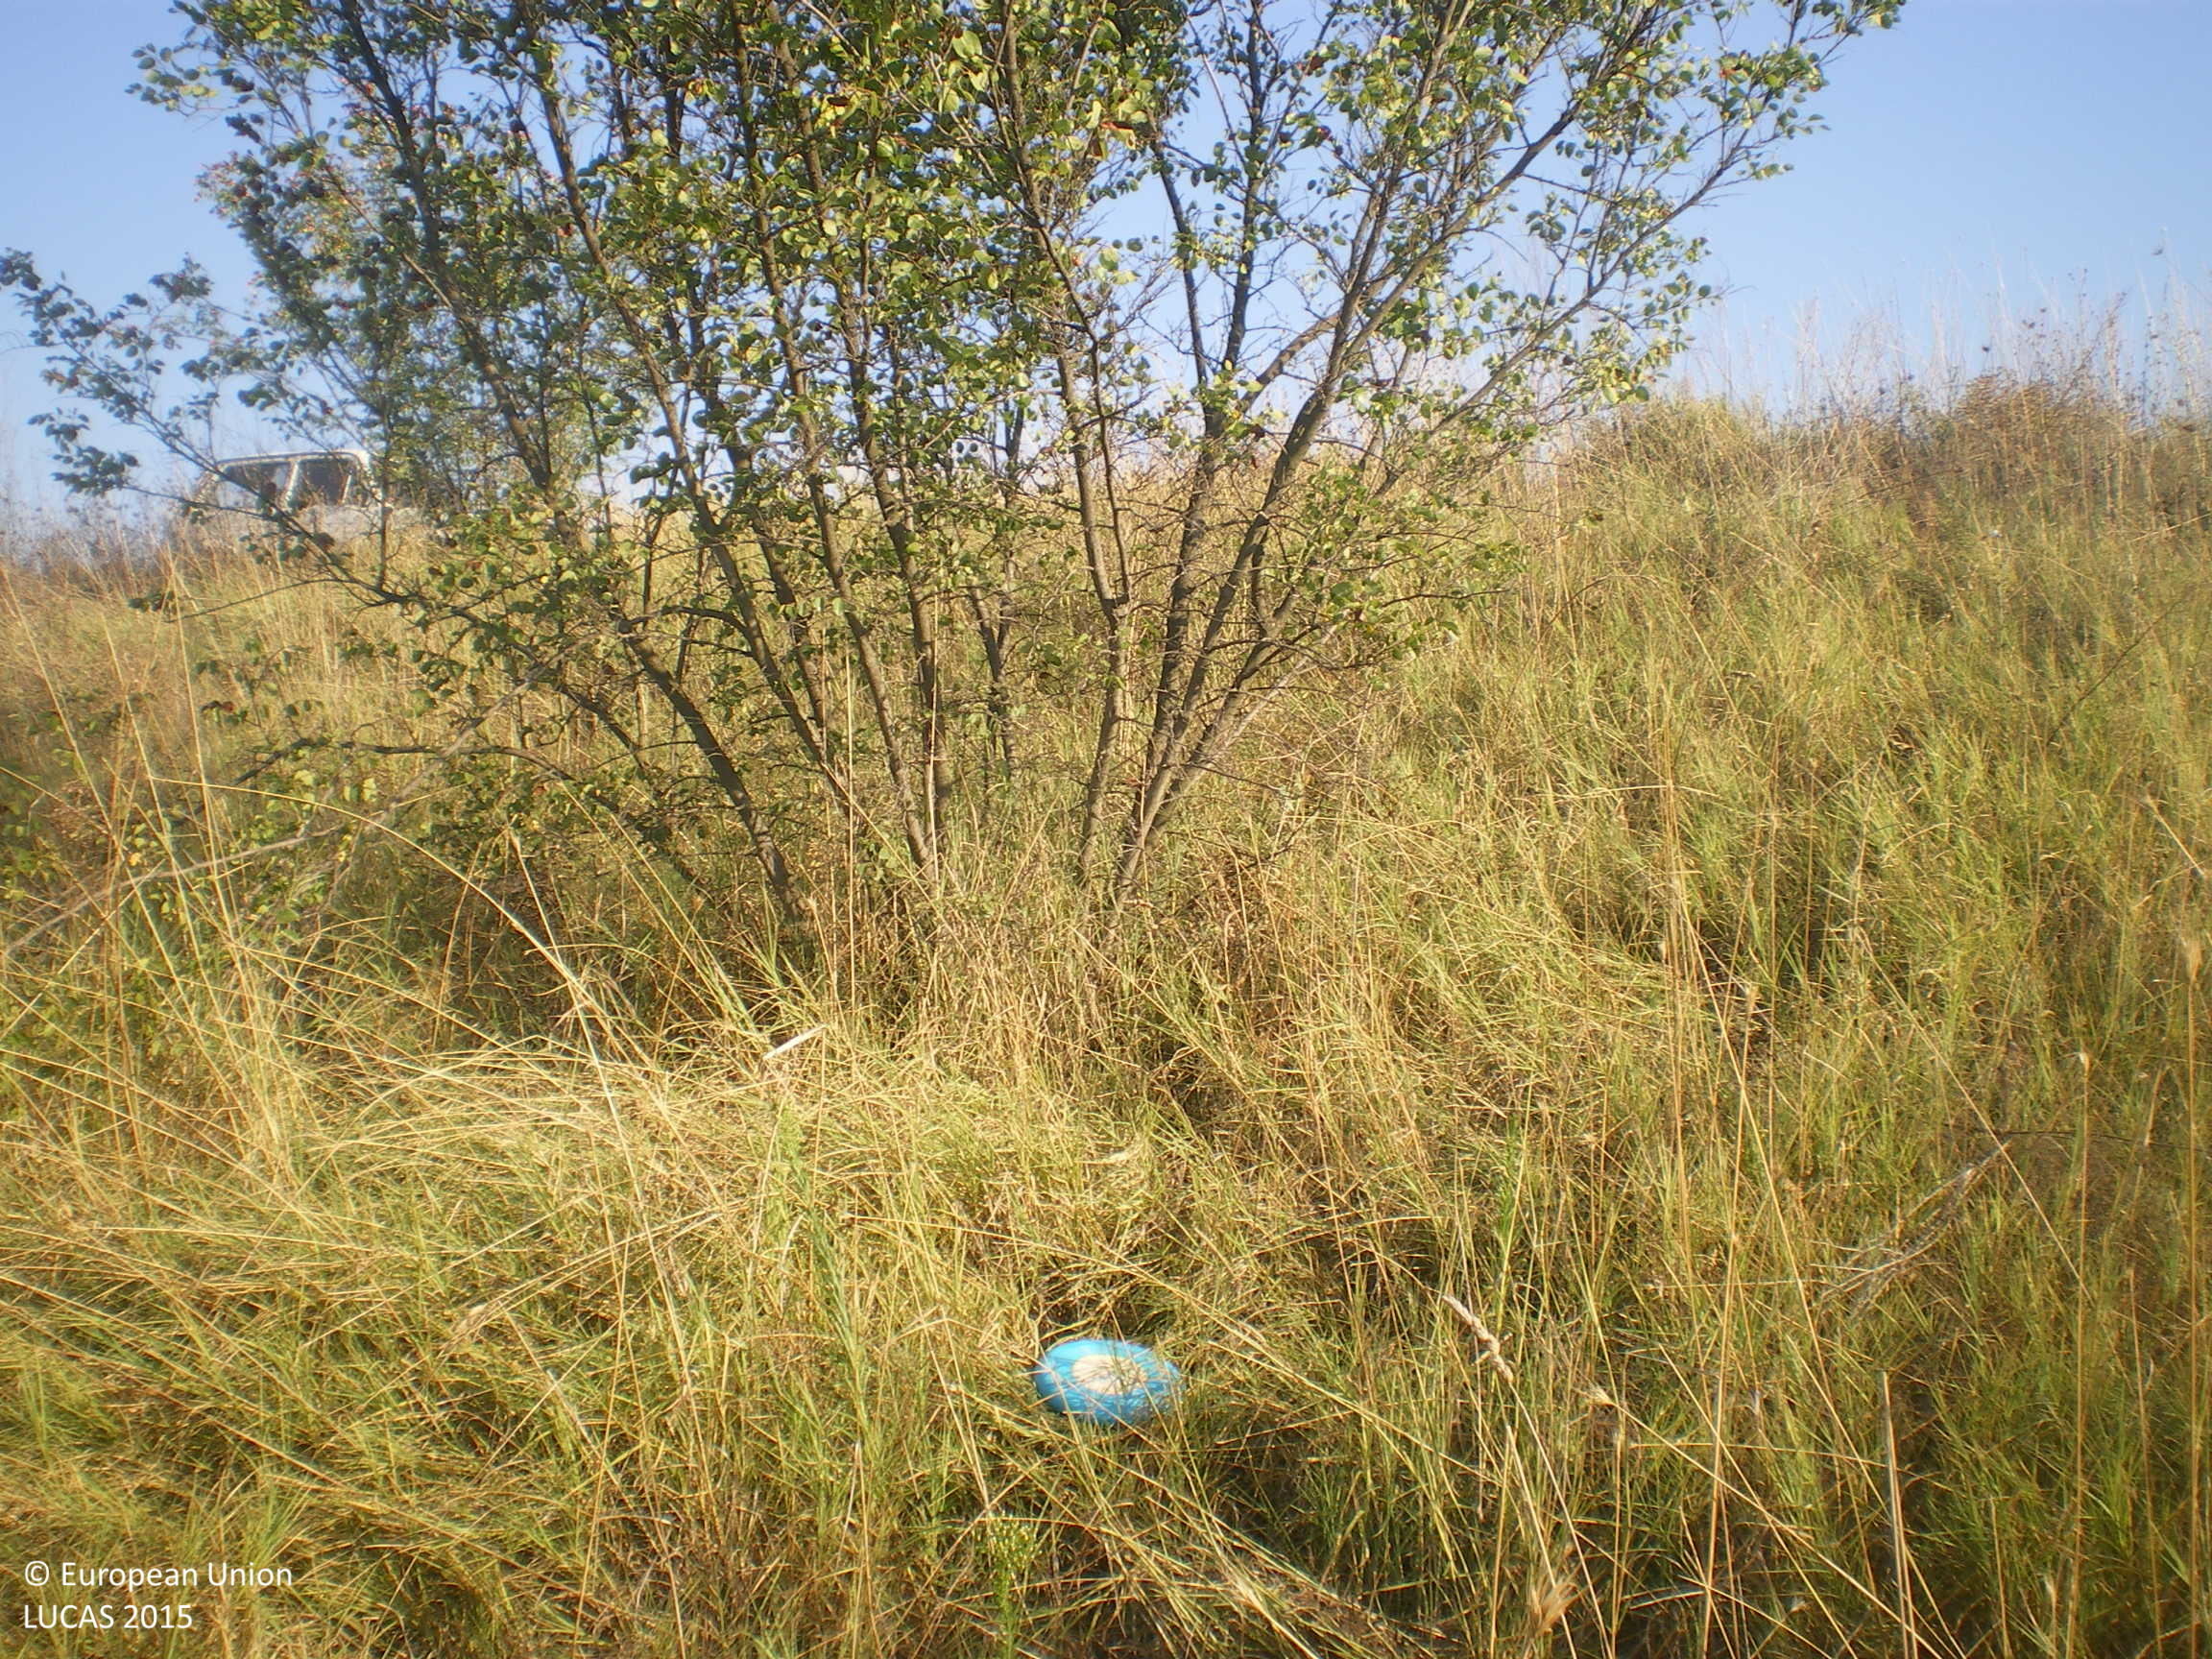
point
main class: Grassland
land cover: Grassland with sparse tree/shrub cover
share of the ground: > 75 %
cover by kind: herbaceous plants 90 %, broadleaved forest trees 5 %, shrubs 5 %
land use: Agriculture (excluding fallow land and kitchen gardens)
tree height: > 5 m
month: August
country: BG
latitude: 42.0480
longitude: 25.9125
